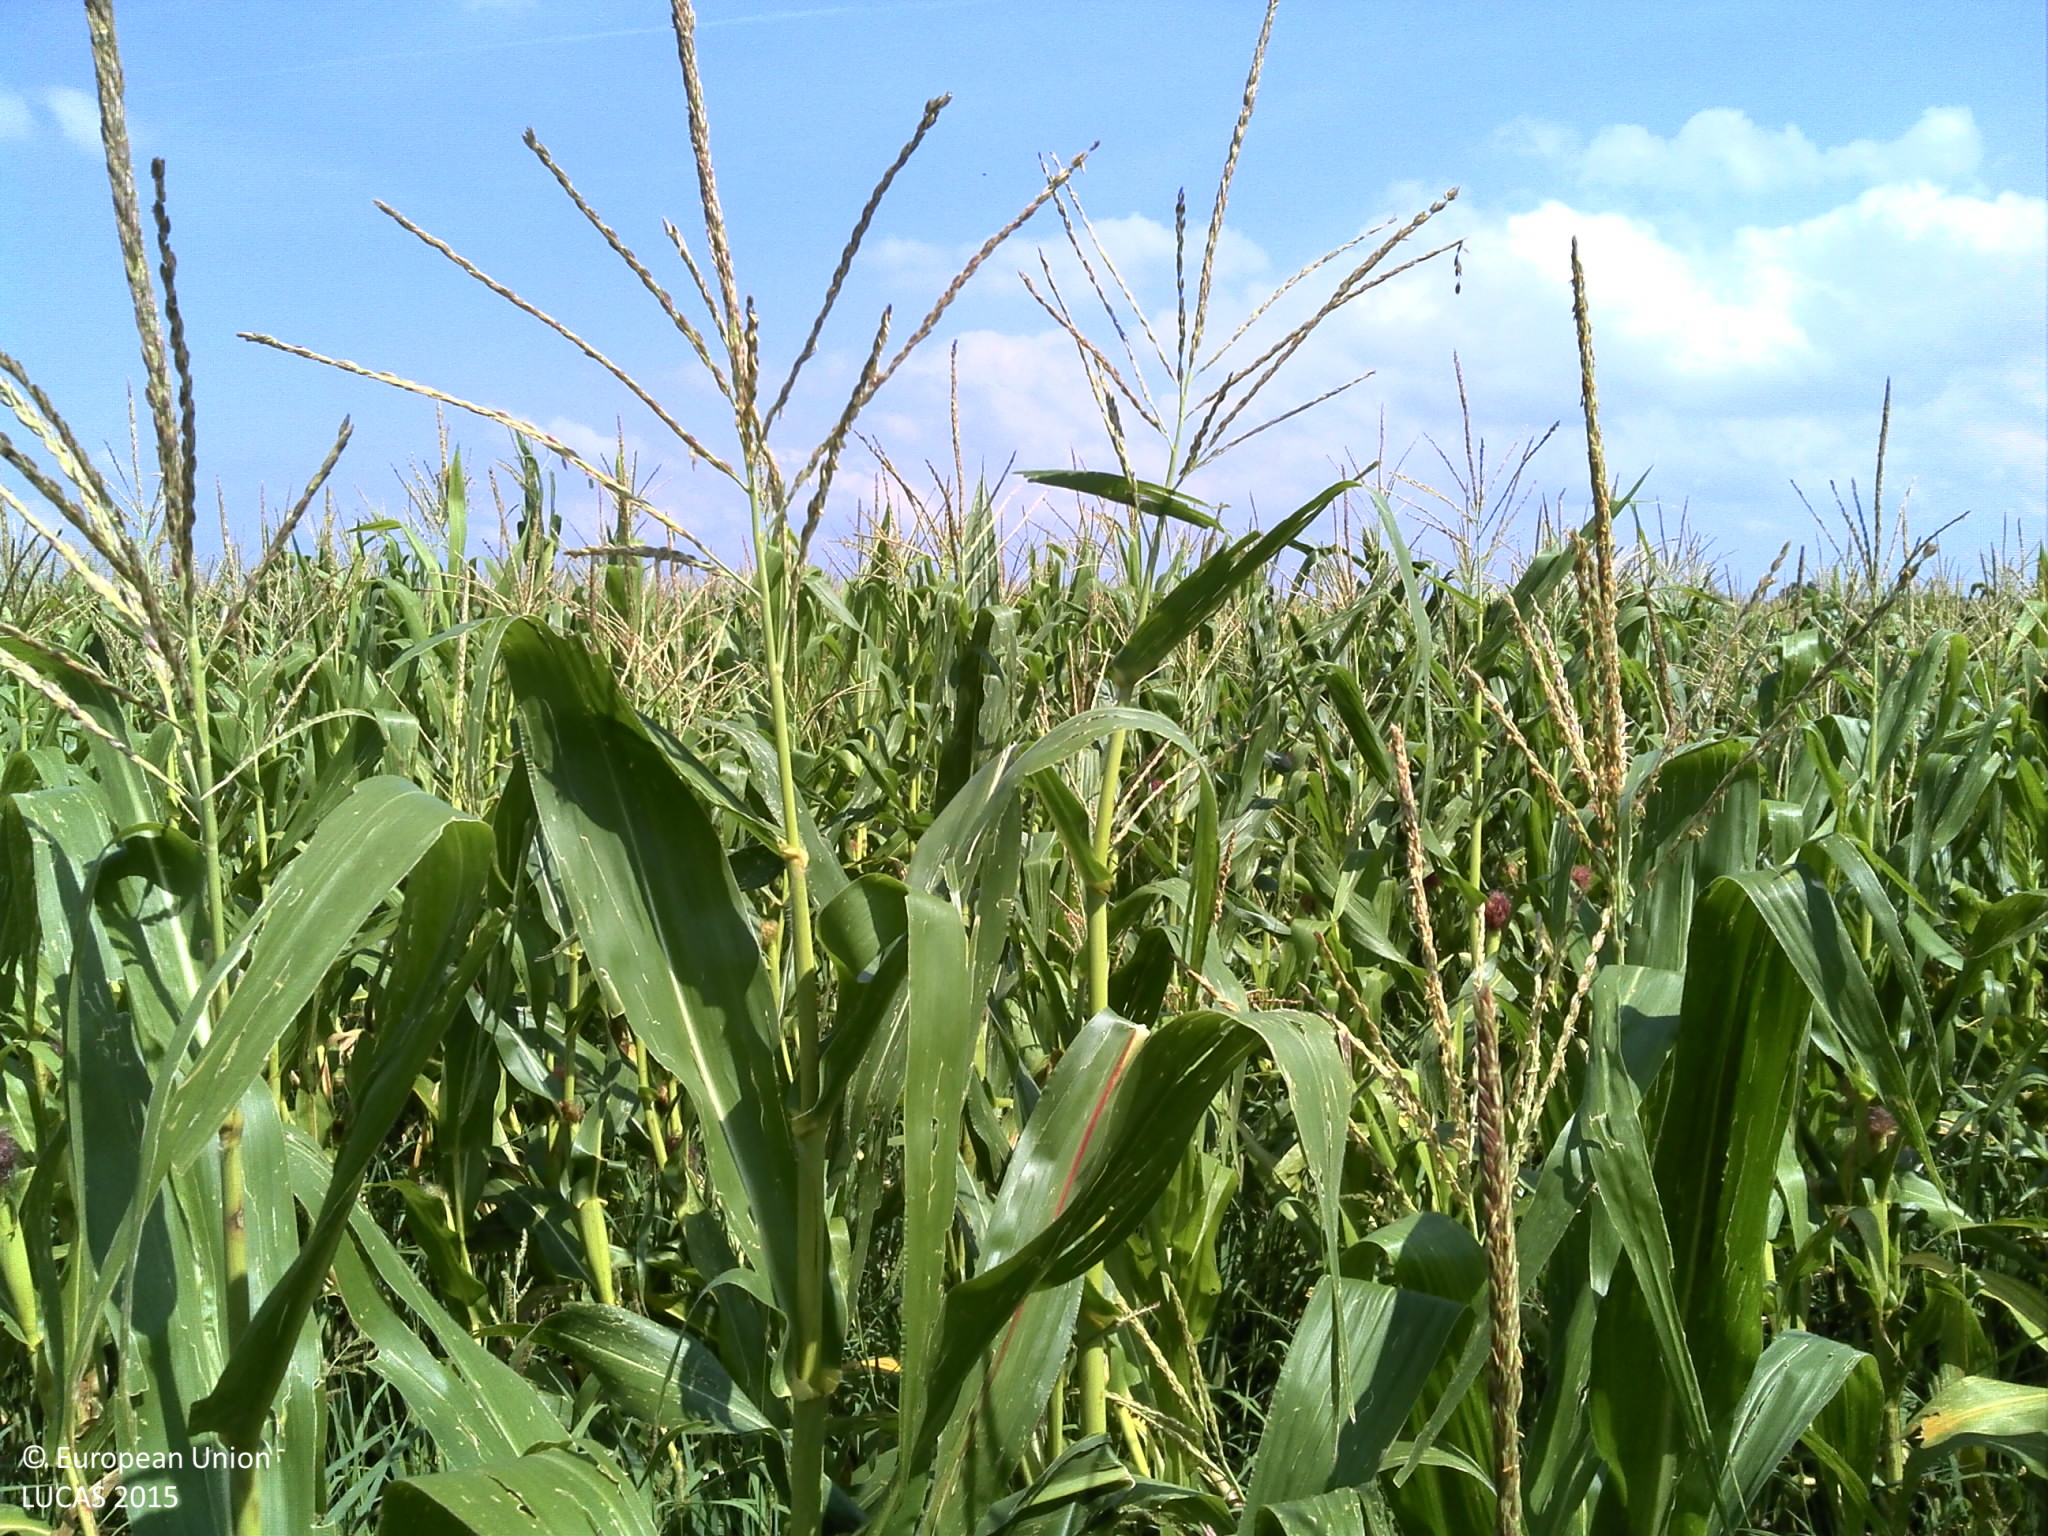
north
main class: Cropland
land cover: Maize
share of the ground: > 75 %
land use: Agriculture (excluding fallow land and kitchen gardens)
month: August
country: HR
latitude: 45.5528
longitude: 16.5699
